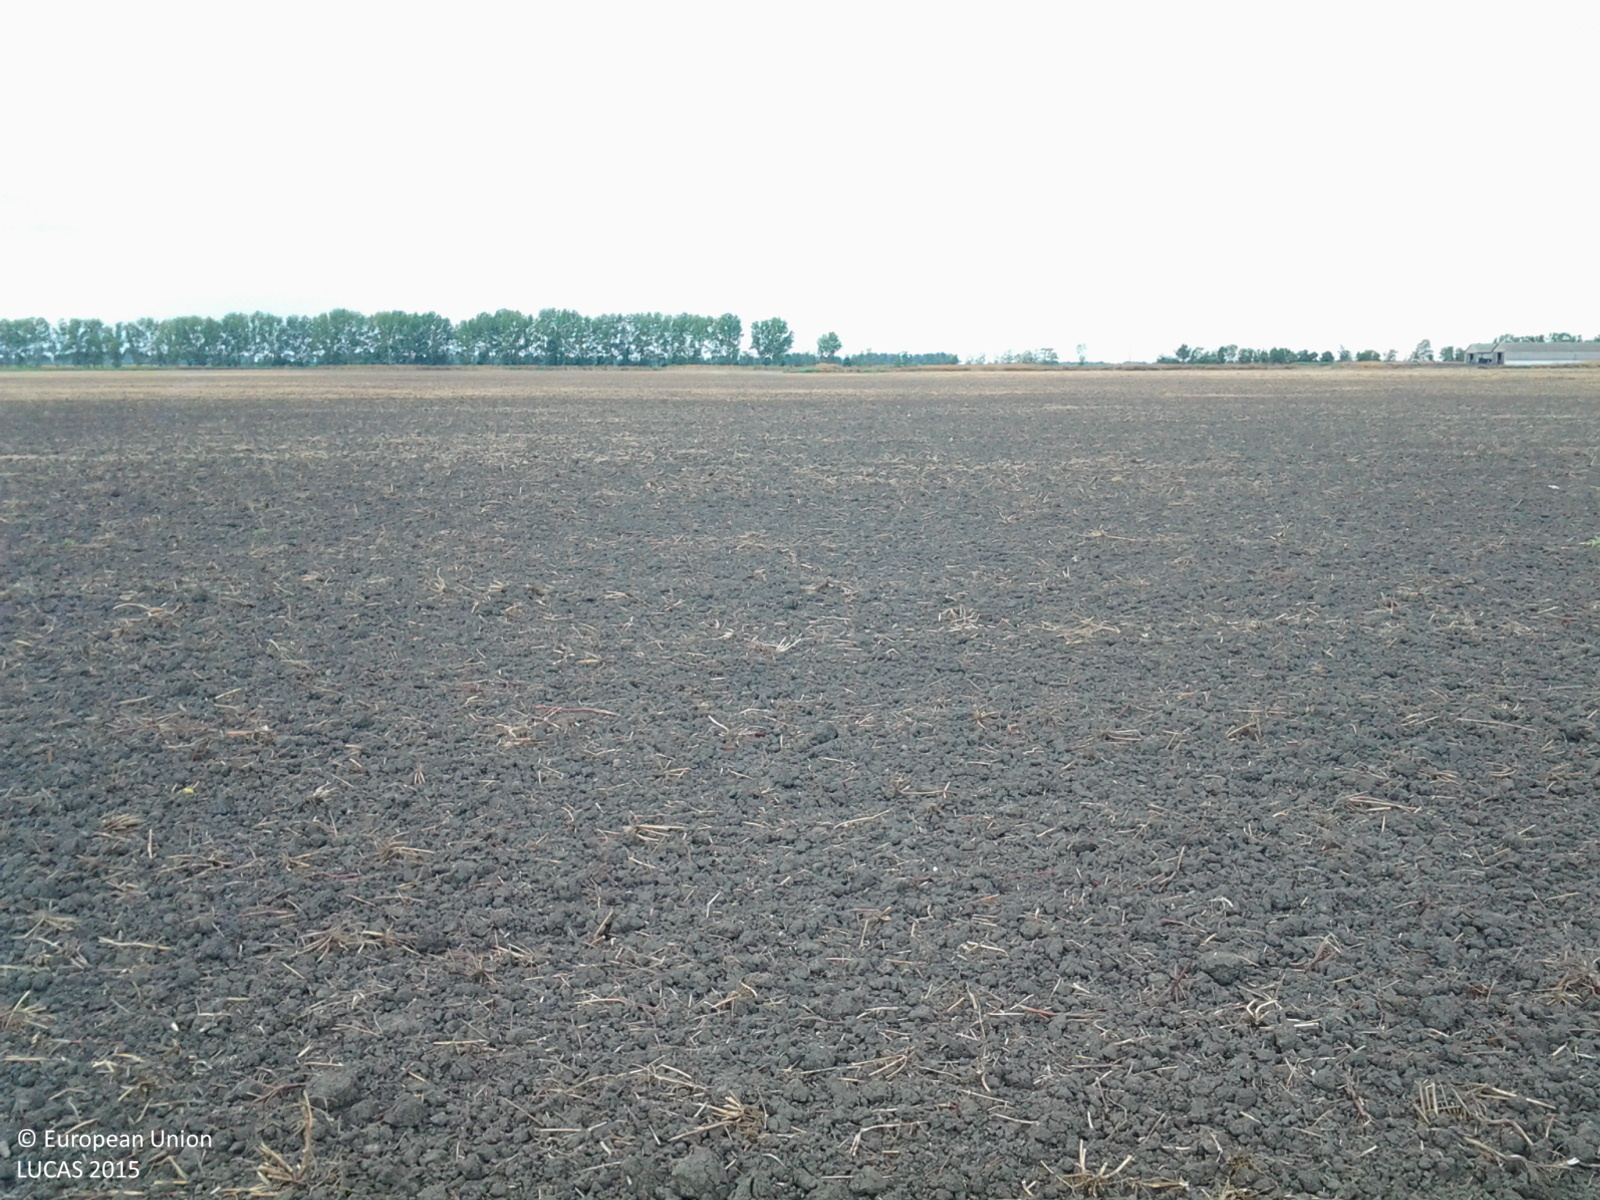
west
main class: Cropland
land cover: Common wheat
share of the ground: < 10 %
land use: Agriculture (excluding fallow land and kitchen gardens)
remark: Harvested field
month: July
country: HU
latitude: 47.1464
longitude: 20.6200
